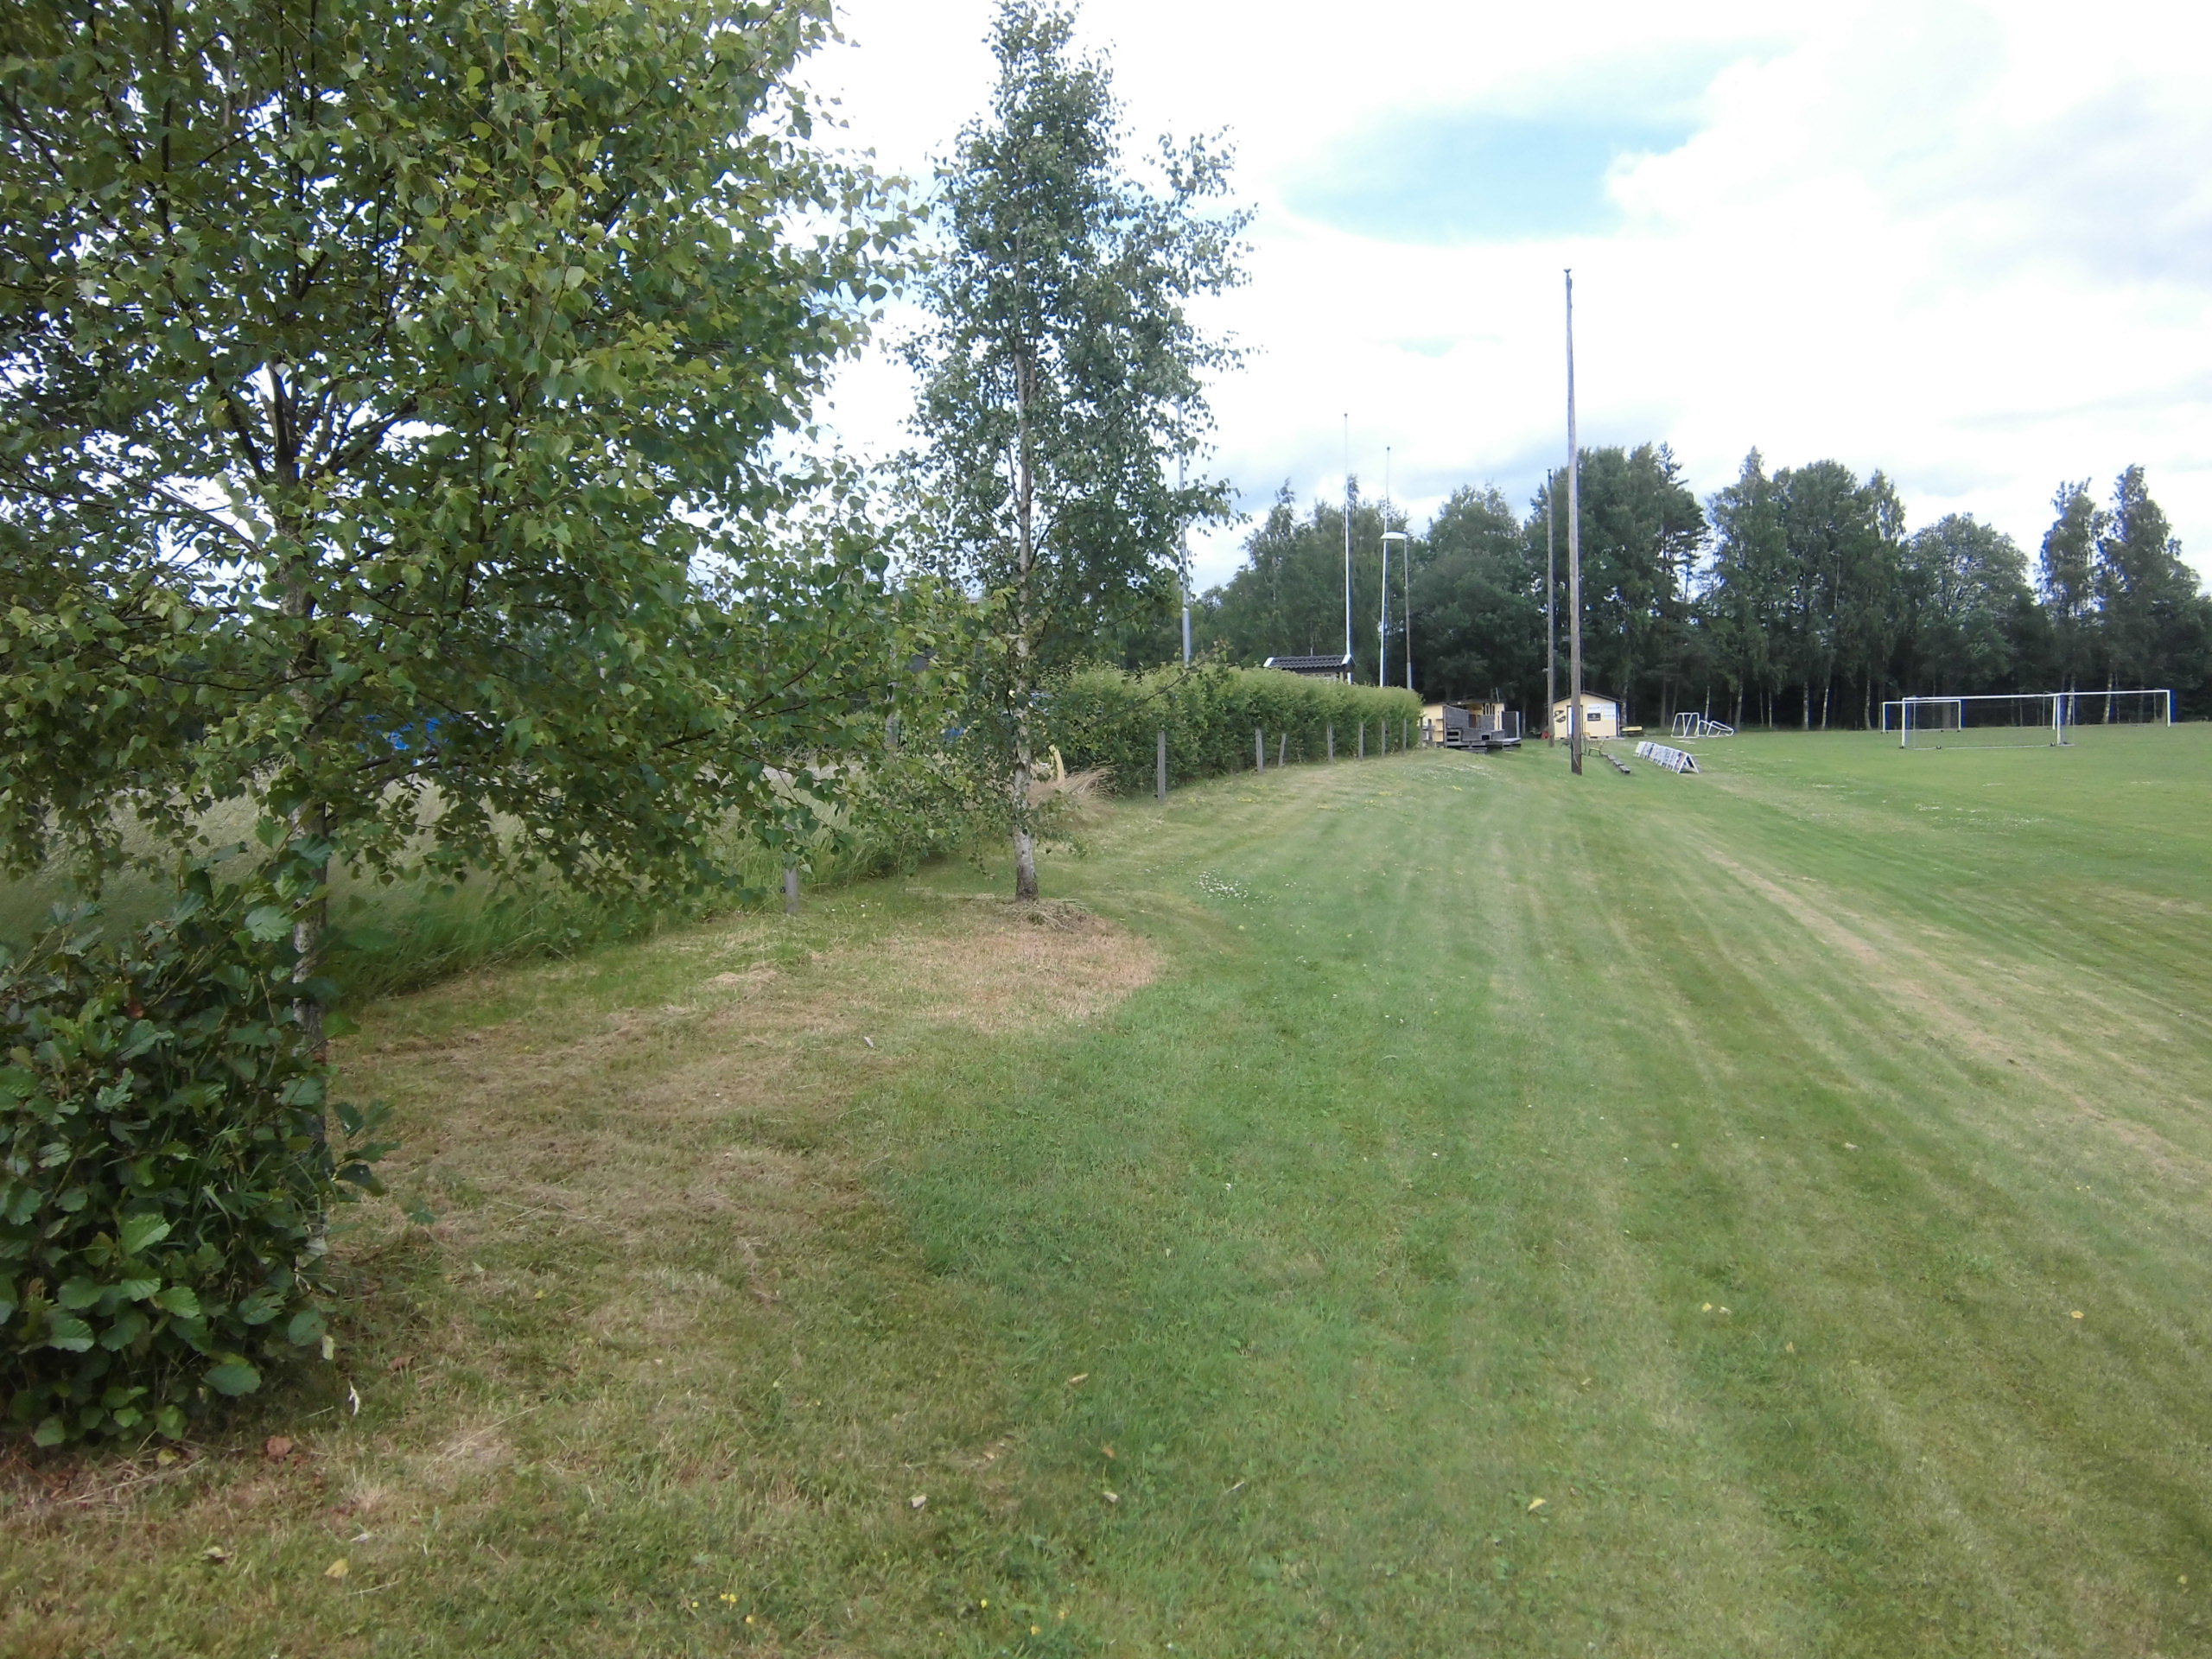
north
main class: Grassland
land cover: Grassland with sparse tree/shrub cover
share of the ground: > 75 %
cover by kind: herbaceous plants 95 %, coniferous forest trees 5 %
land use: Sport
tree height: < 5 m
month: July
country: SE
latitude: 57.3107
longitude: 15.1265
